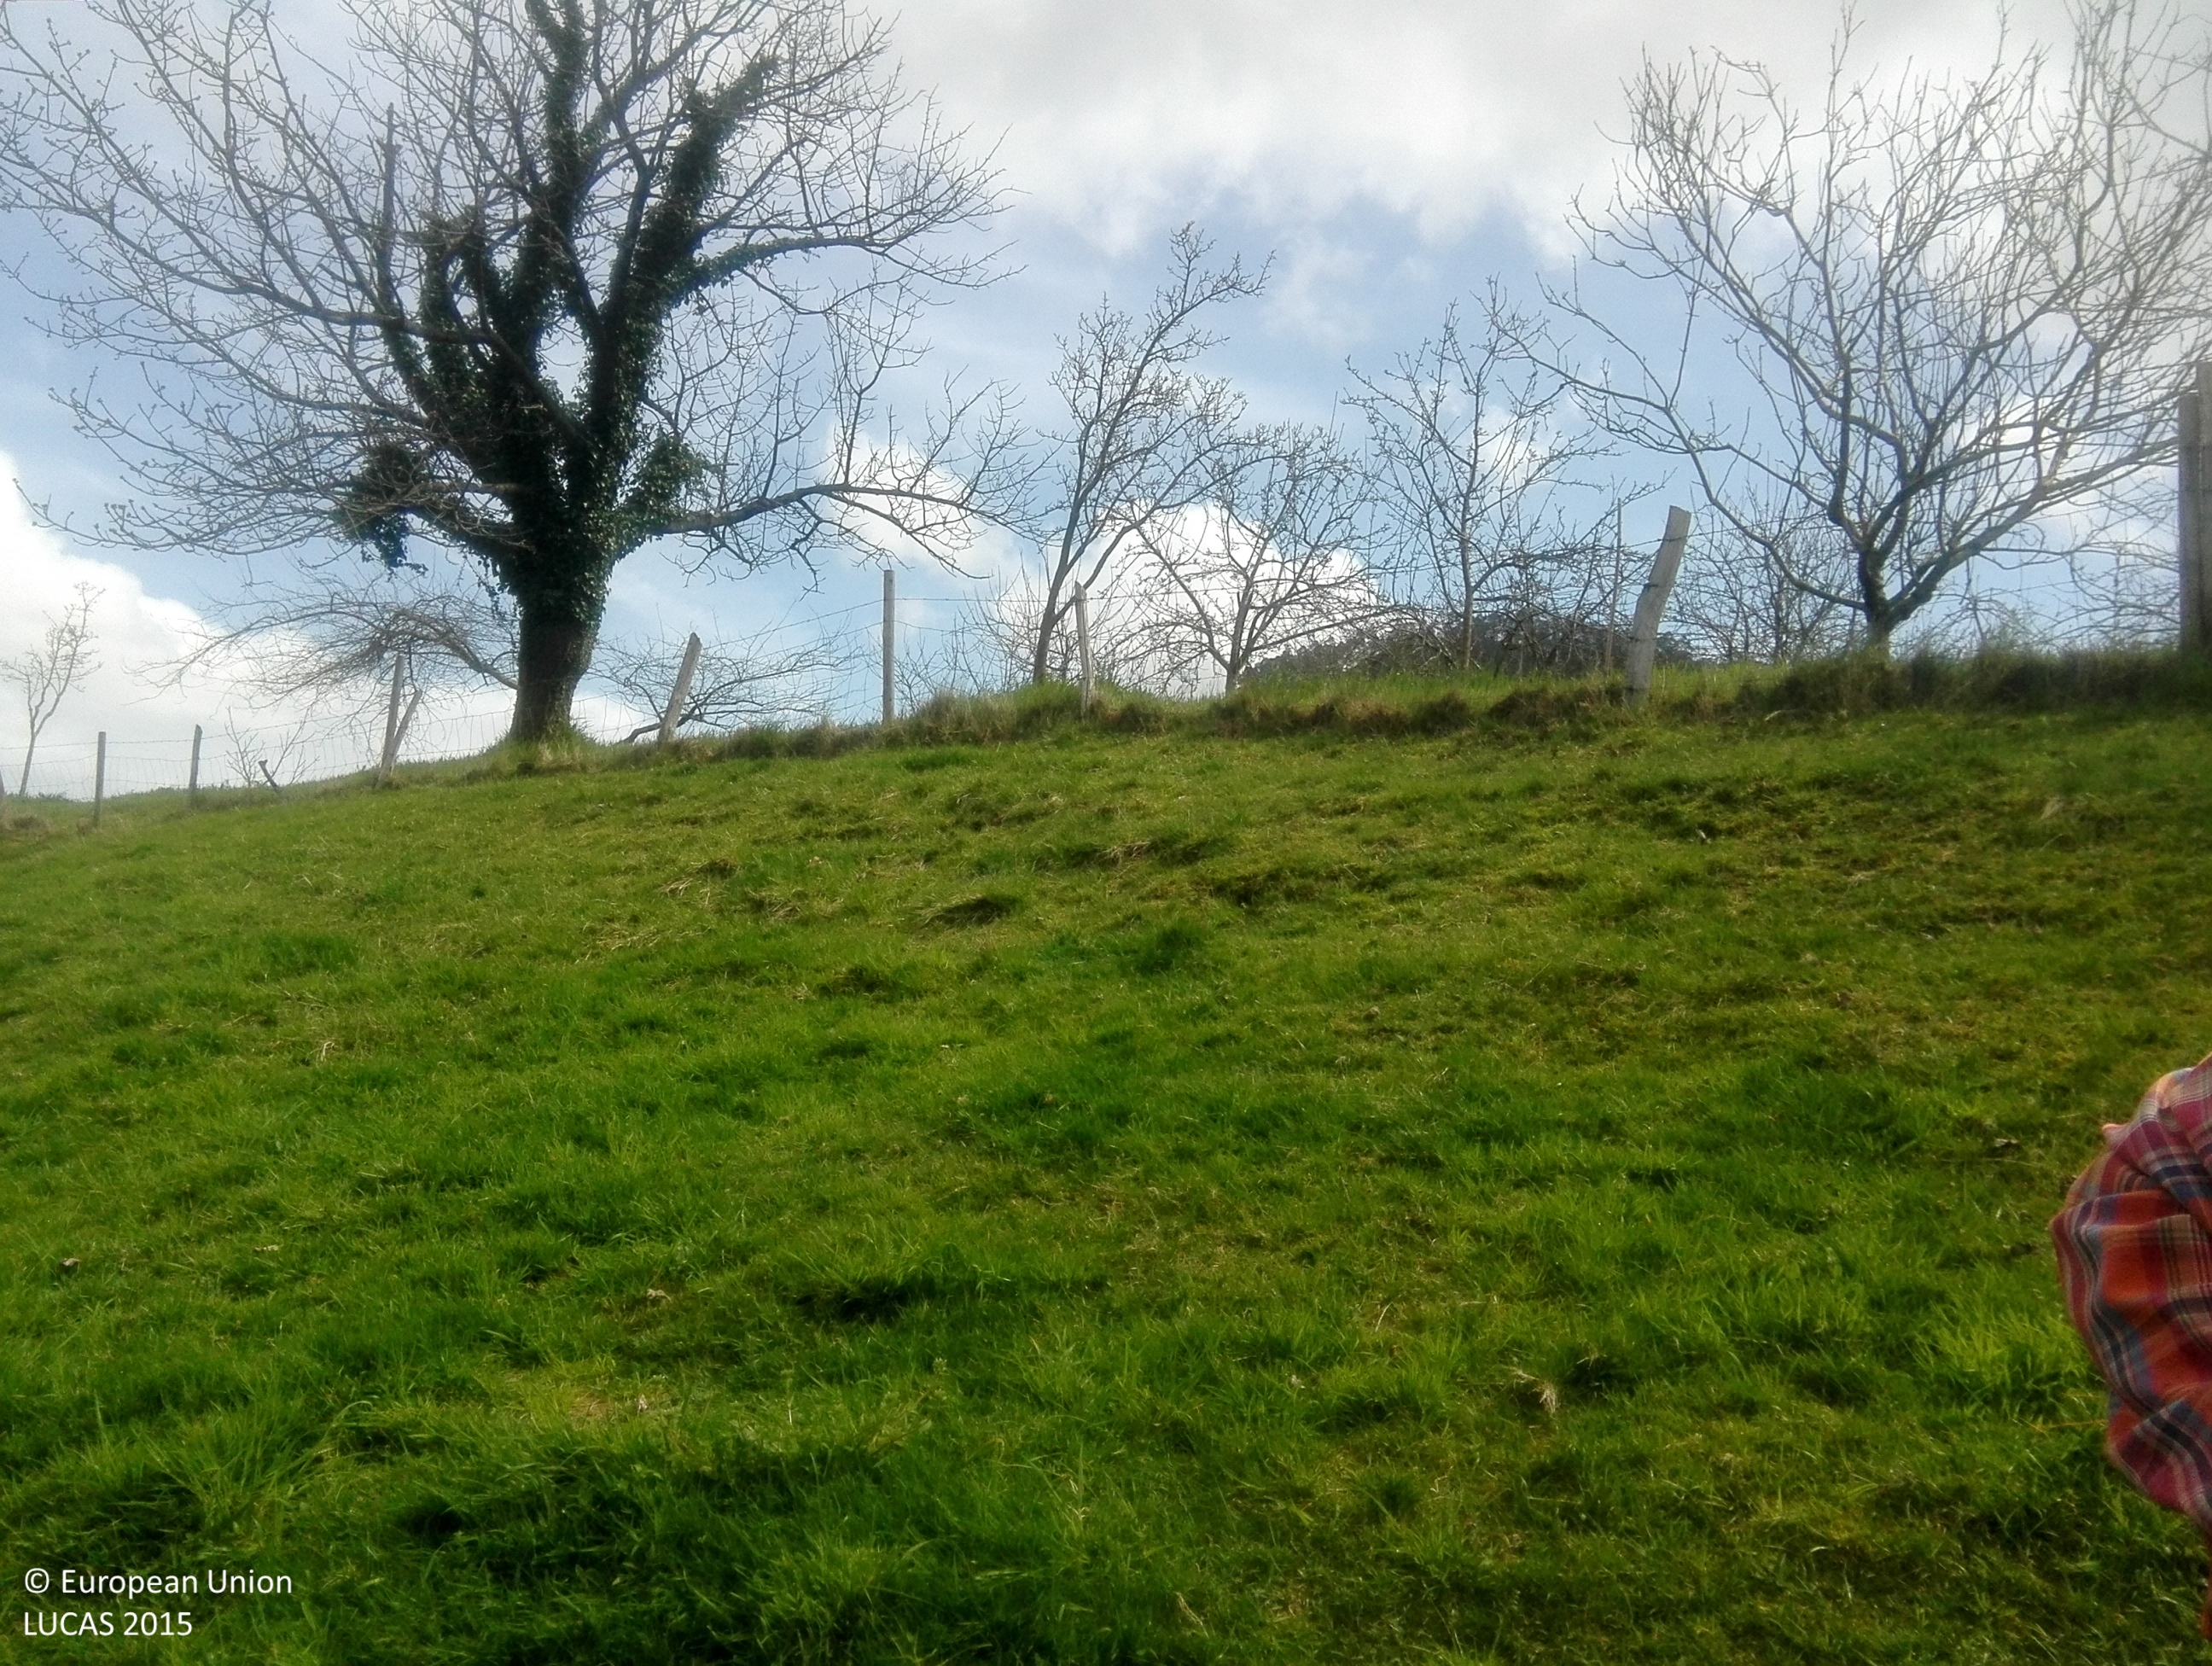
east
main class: Cropland
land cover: Apple fruit
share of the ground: 50 - 75 %
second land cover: Grassland without tree/shrub cover
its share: > 75 %
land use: Agriculture (excluding fallow land and kitchen gardens)
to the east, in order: Apple fruit; Grassland without tree/shrub cover; Grassland with sparse tree/shrub cover; Apple fruit; Artificial constructions in urban areas; Electric lines; Fences; Apple fruit; Fences; Paved roads, cycling and walking lanes; Fences; Apple fruit; Fences; Tracks; Broadleaved woodland
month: April
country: ES
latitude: 43.4667
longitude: -5.6465
